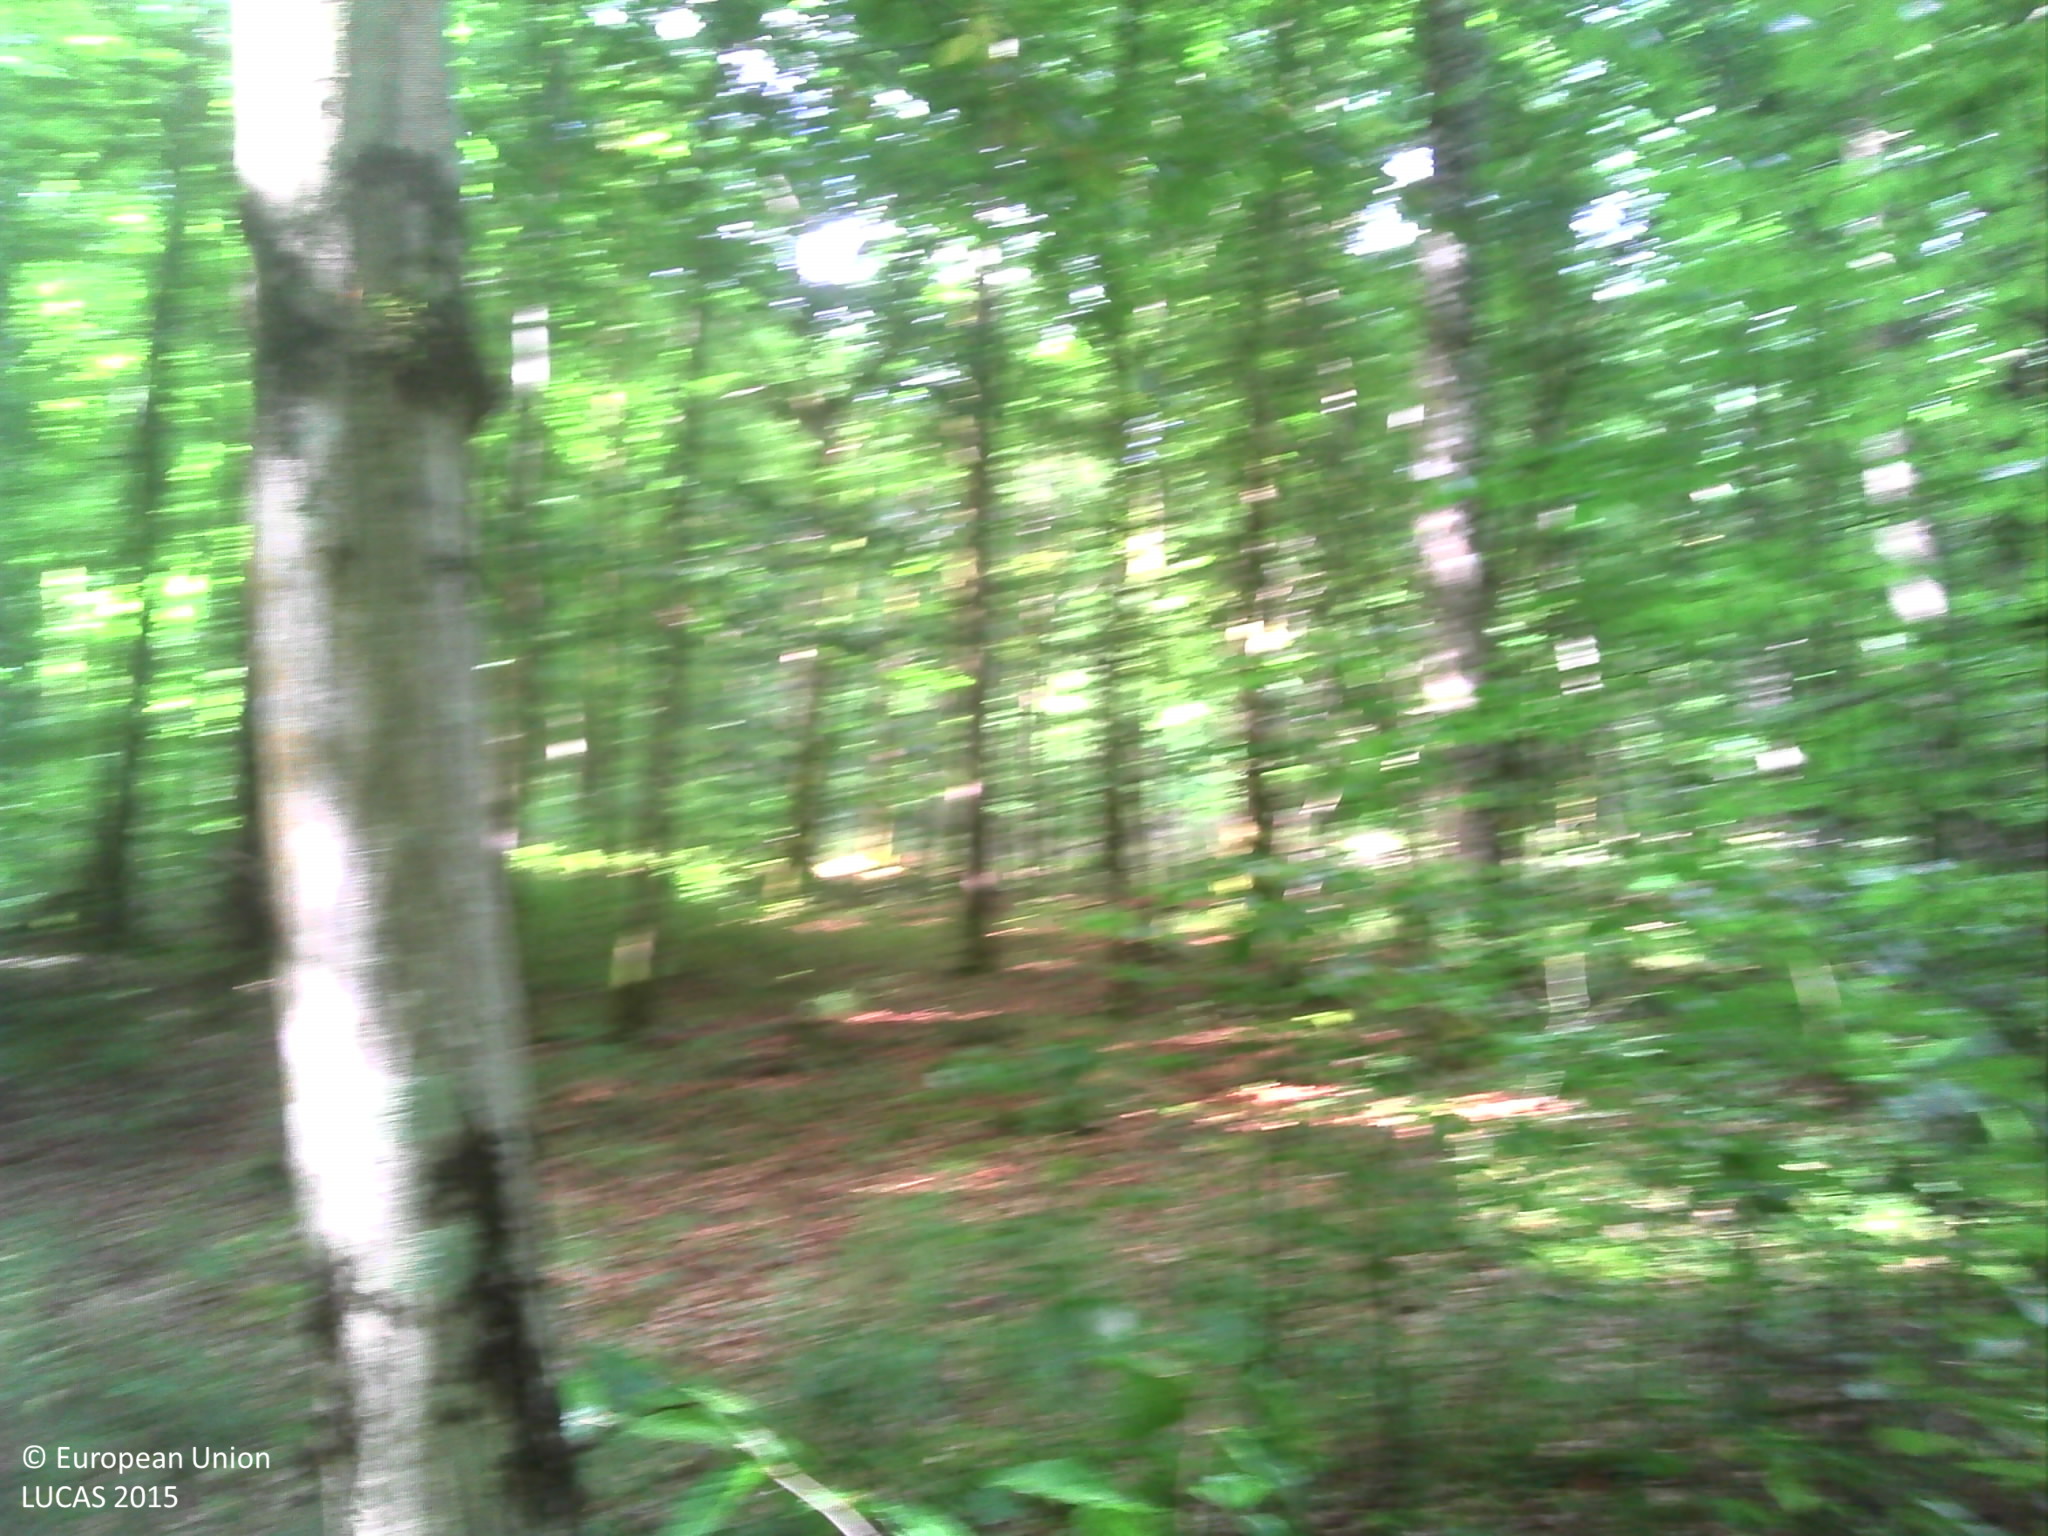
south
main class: Woodland
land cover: Broadleaved woodland
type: acidophilous oak and oak-birch forest
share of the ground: > 75 %
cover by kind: broadleaved forest trees 80 %, herbaceous plants 10 %, lichens and mosses 10 %
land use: Forestry
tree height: > 5 m
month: July
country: FR
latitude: 47.9685
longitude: 5.0568
